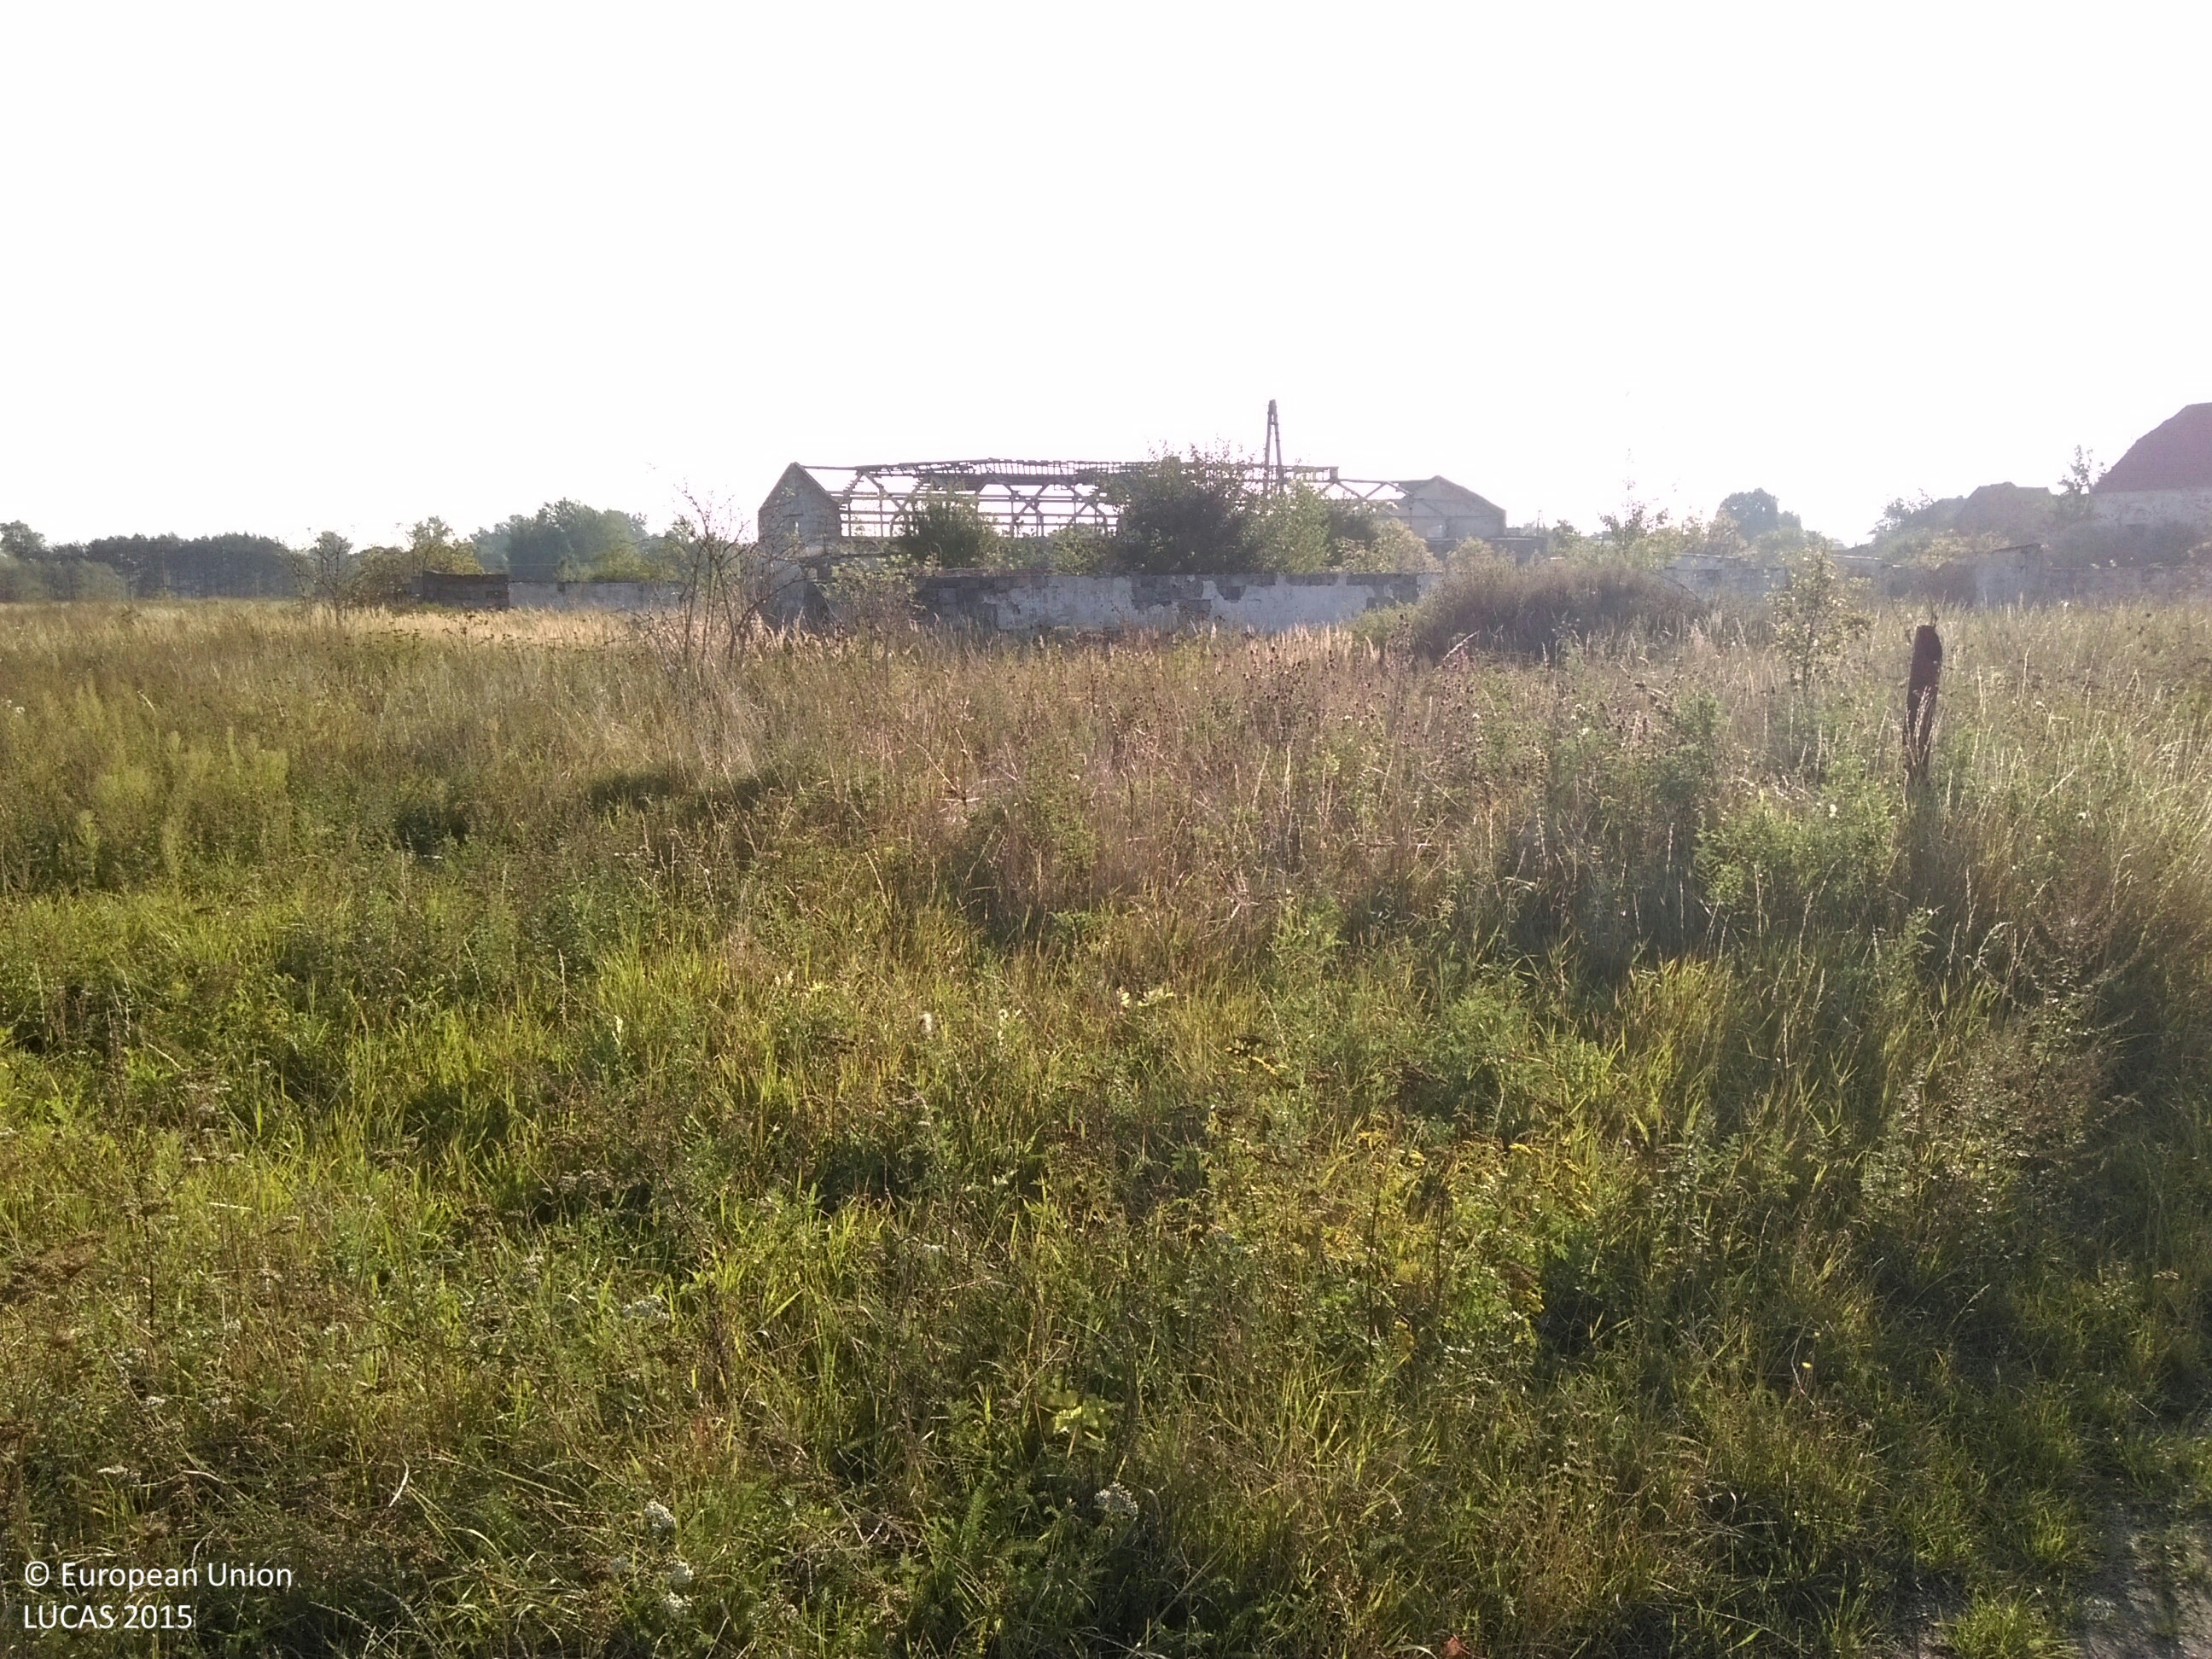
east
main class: Cropland
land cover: Triticale
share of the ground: < 10 %
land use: Agriculture (excluding fallow land and kitchen gardens)
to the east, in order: Triticale; Fences; Grass margins; Tracks; Grass margins; Spontaneously vegetated surfaces
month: September
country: PL
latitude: 51.7969
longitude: 15.5579
